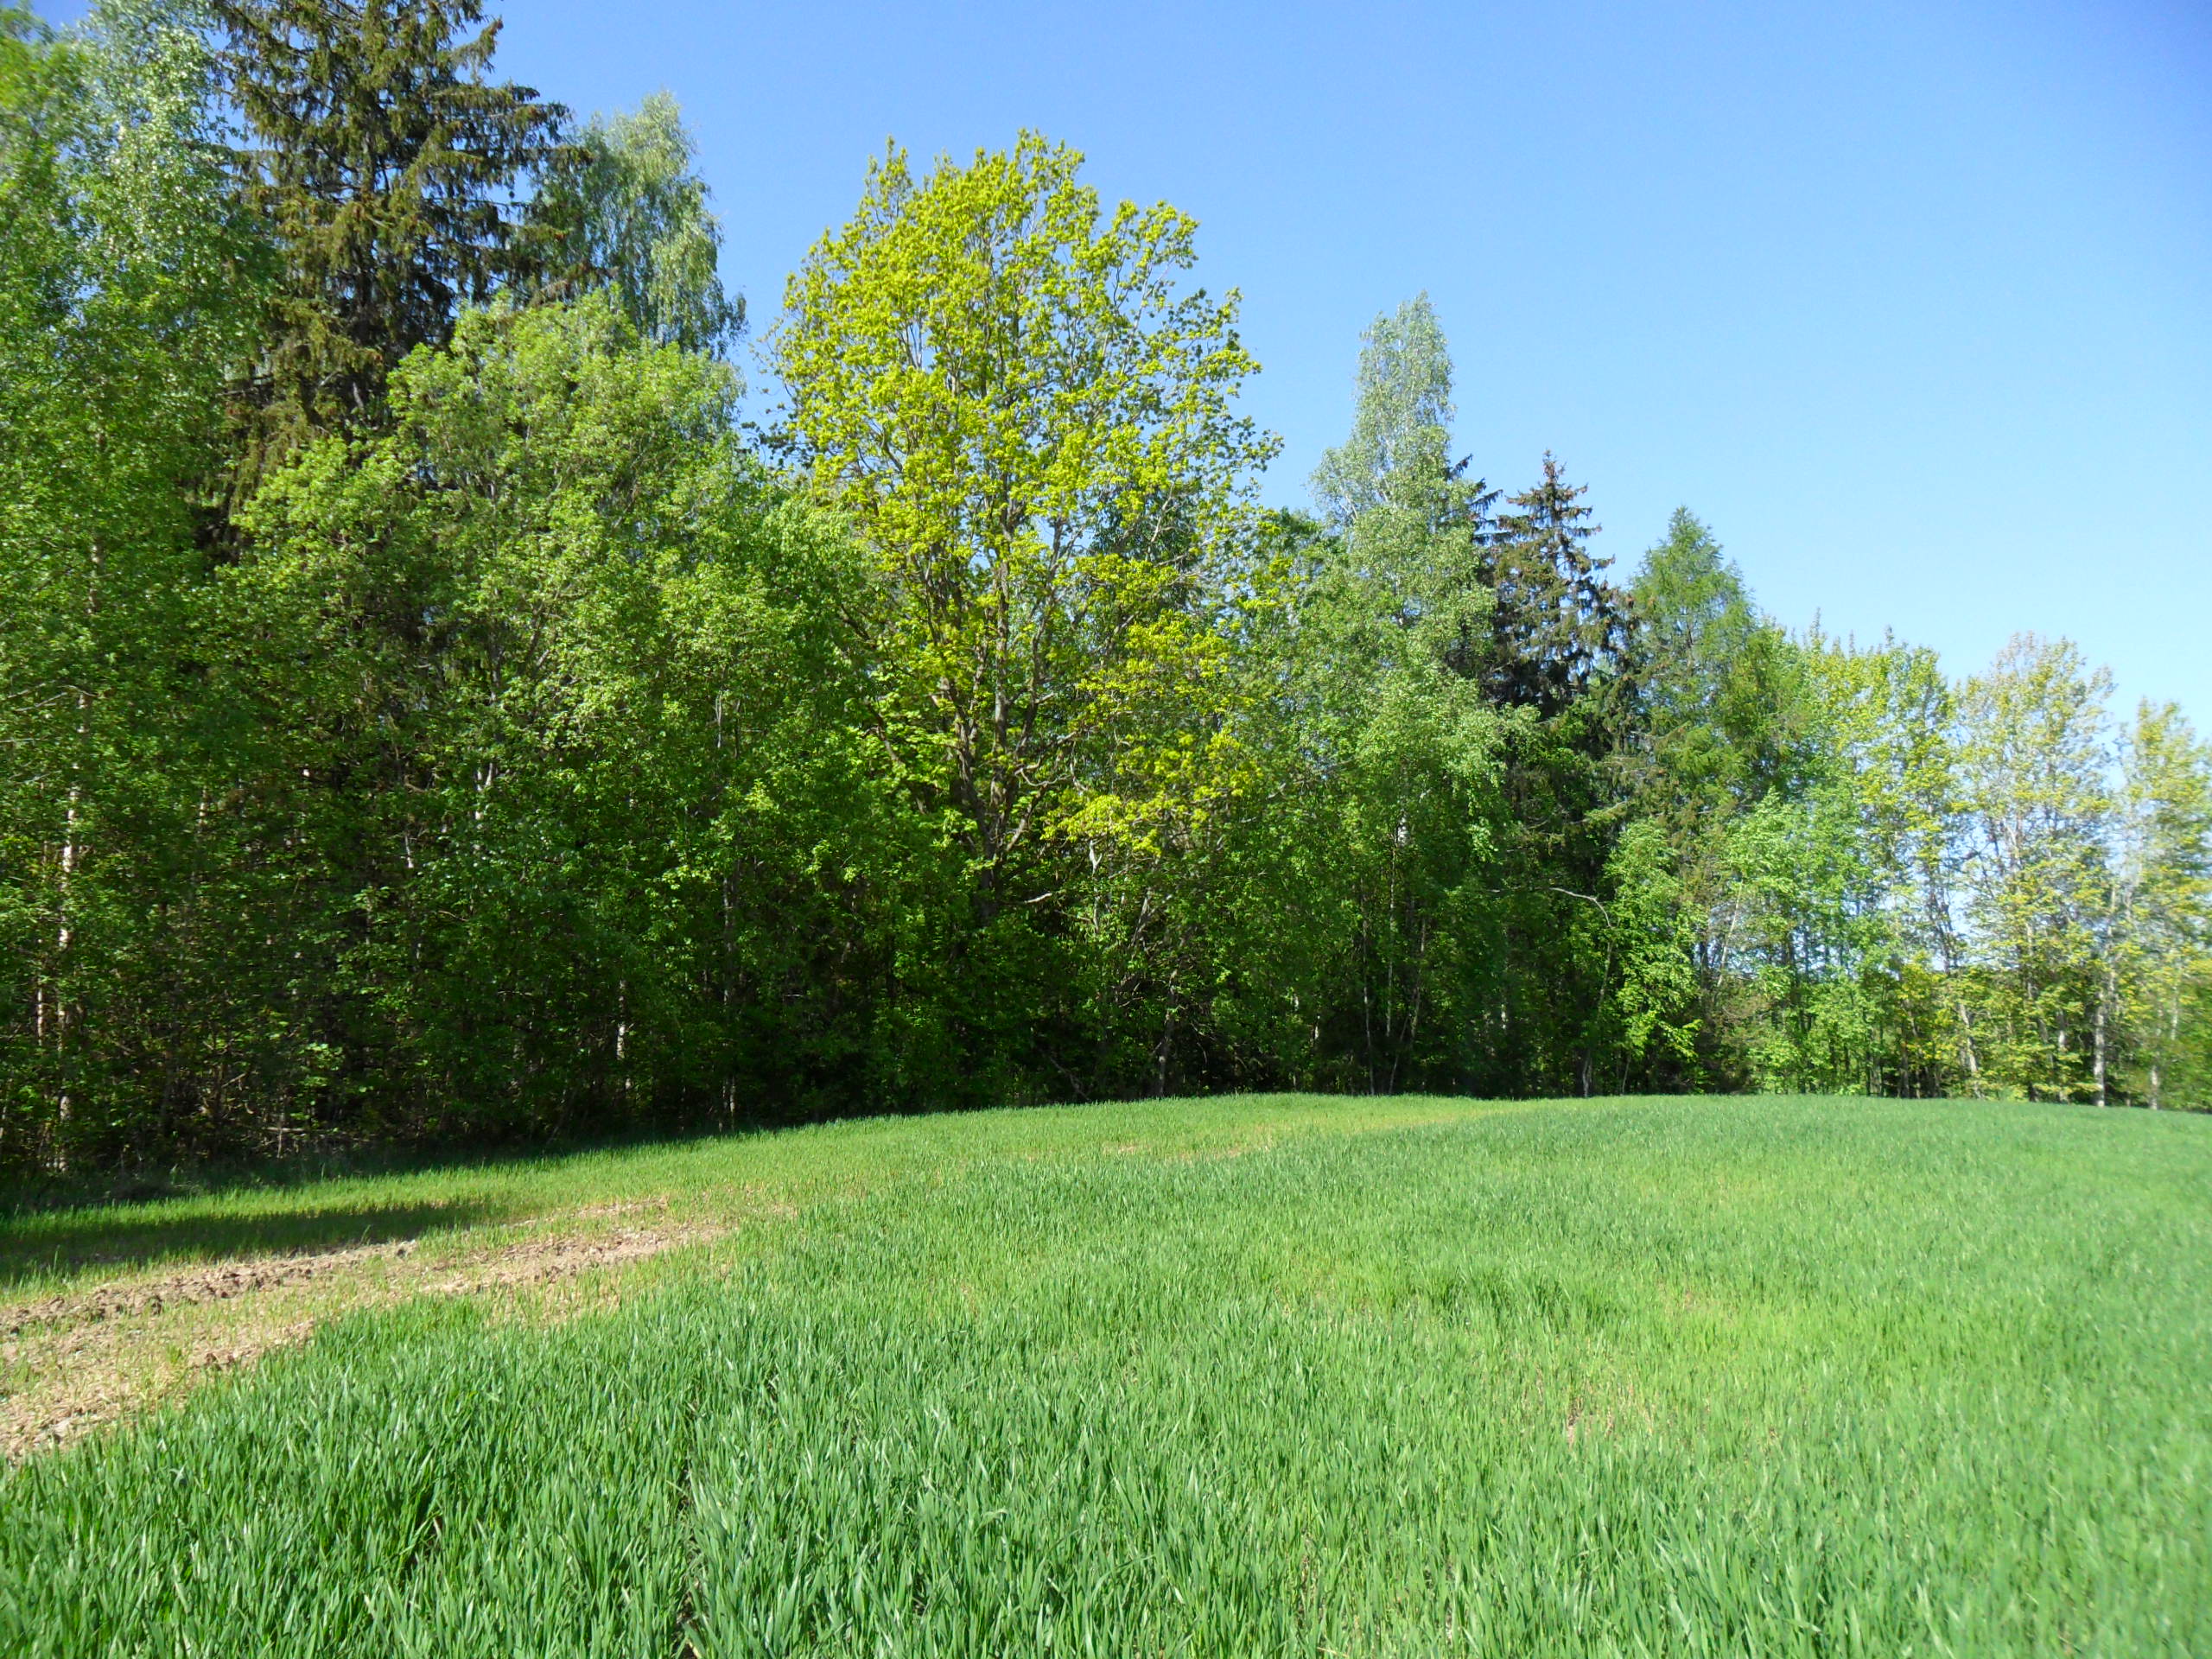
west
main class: Cropland
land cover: Barley
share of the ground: > 75 %
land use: Agriculture (excluding fallow land and kitchen gardens)
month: May
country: LV
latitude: 57.2293
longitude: 22.5277
